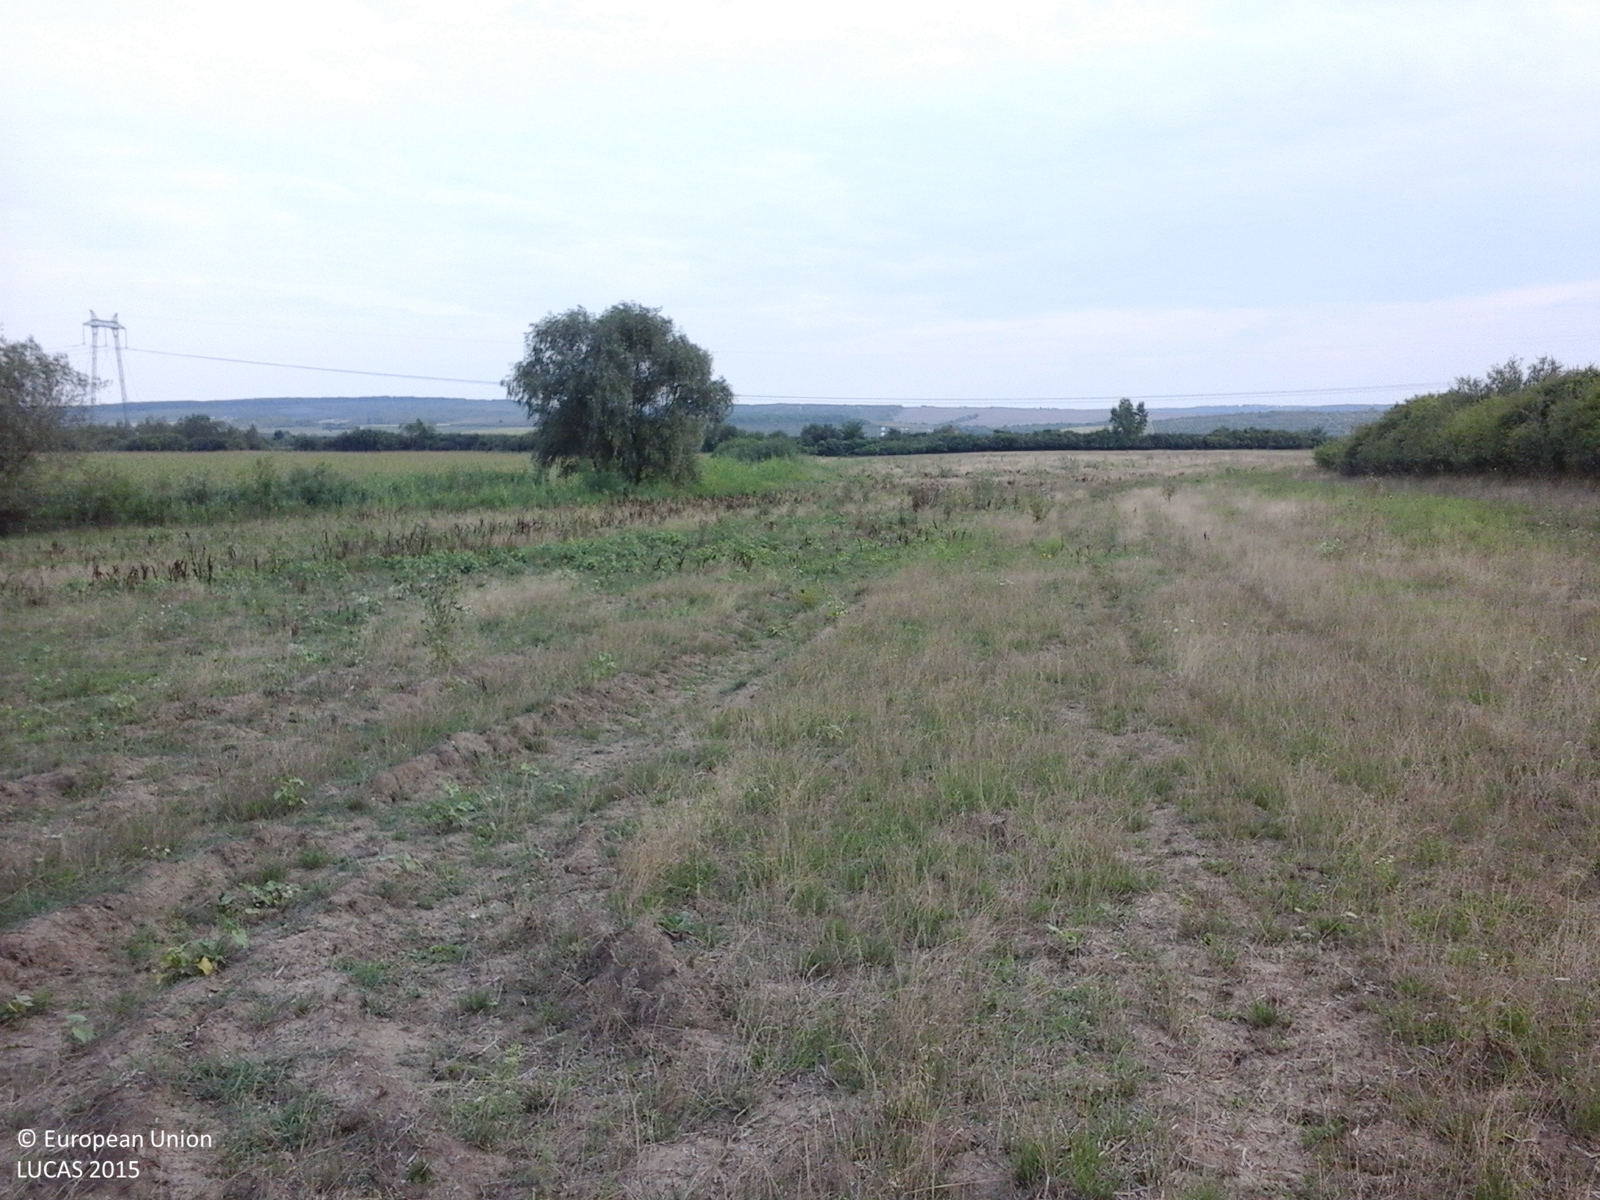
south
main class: Grassland
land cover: Spontaneously vegetated surfaces
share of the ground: > 75 %
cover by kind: herbaceous plants 90 %, consolidated bare surface 10 %
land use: Fallow land
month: August
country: RO
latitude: 46.0776
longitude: 21.6359
